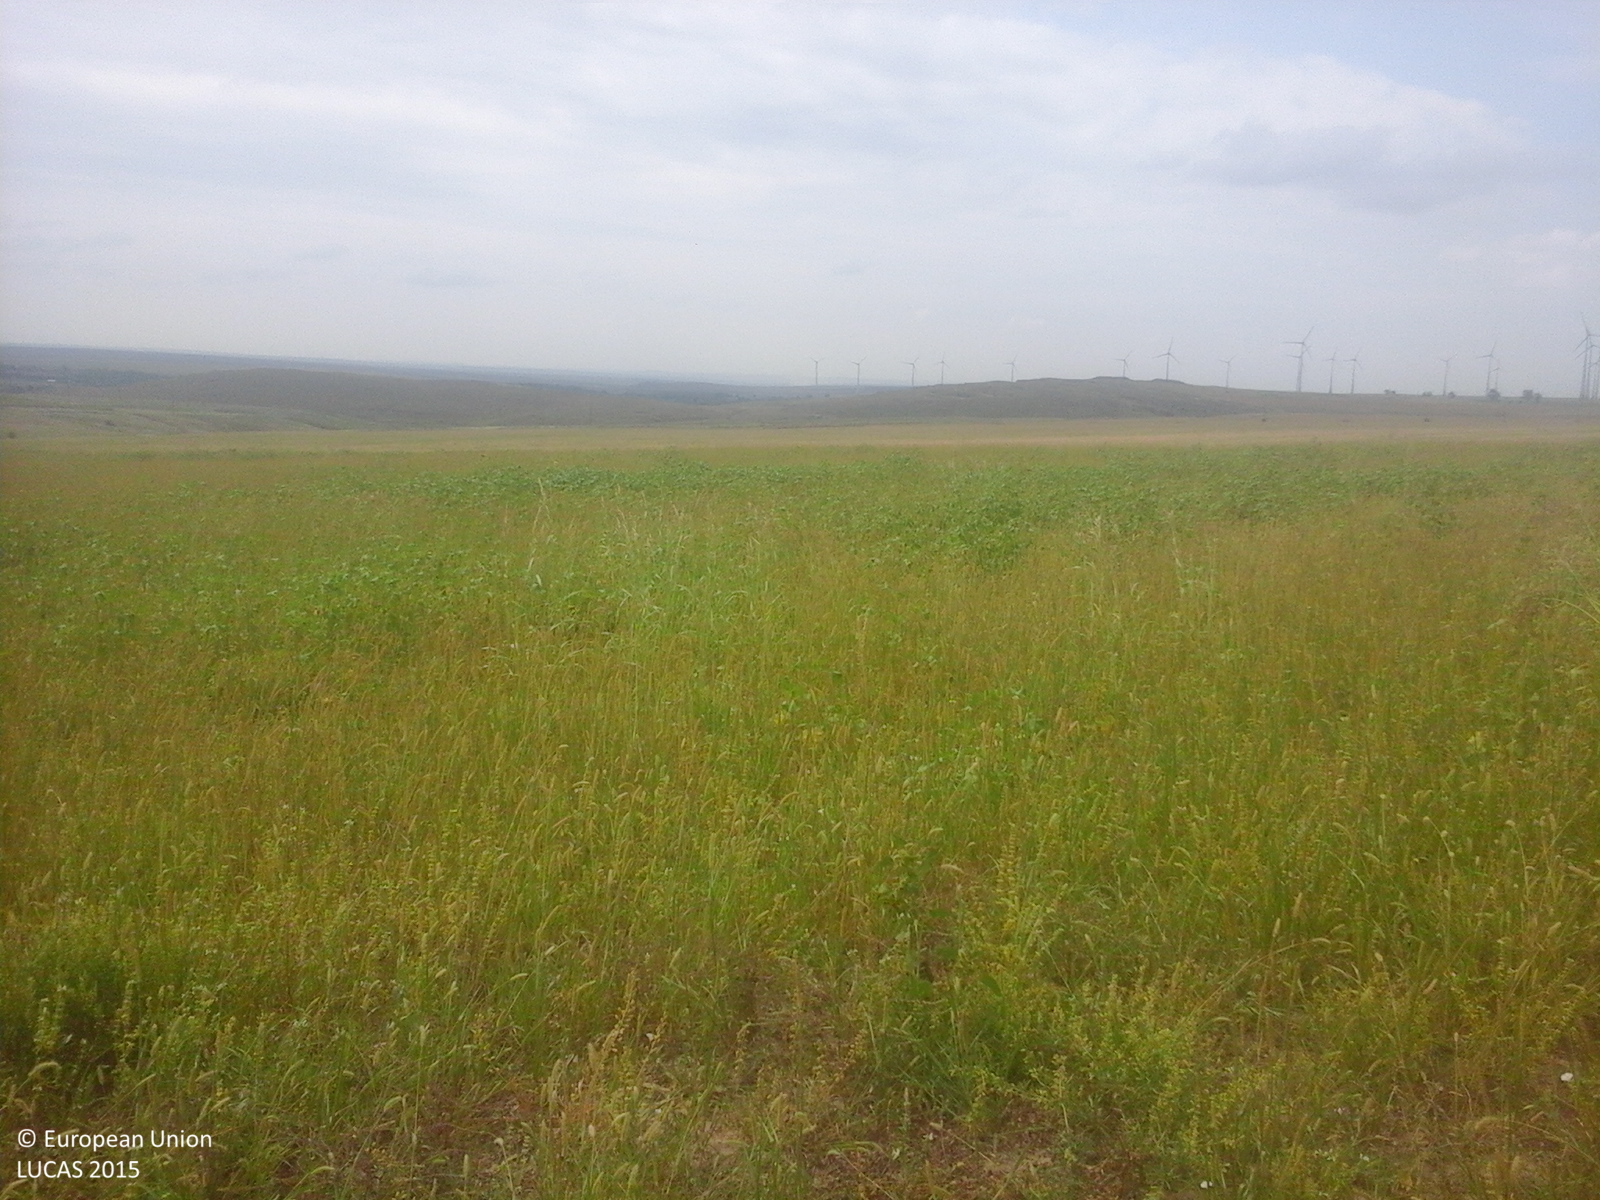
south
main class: Grassland
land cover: Spontaneously vegetated surfaces
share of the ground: > 75 %
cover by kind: herbaceous plants 100 %
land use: Fallow land
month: August
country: RO
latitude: 44.7420
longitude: 28.3713
